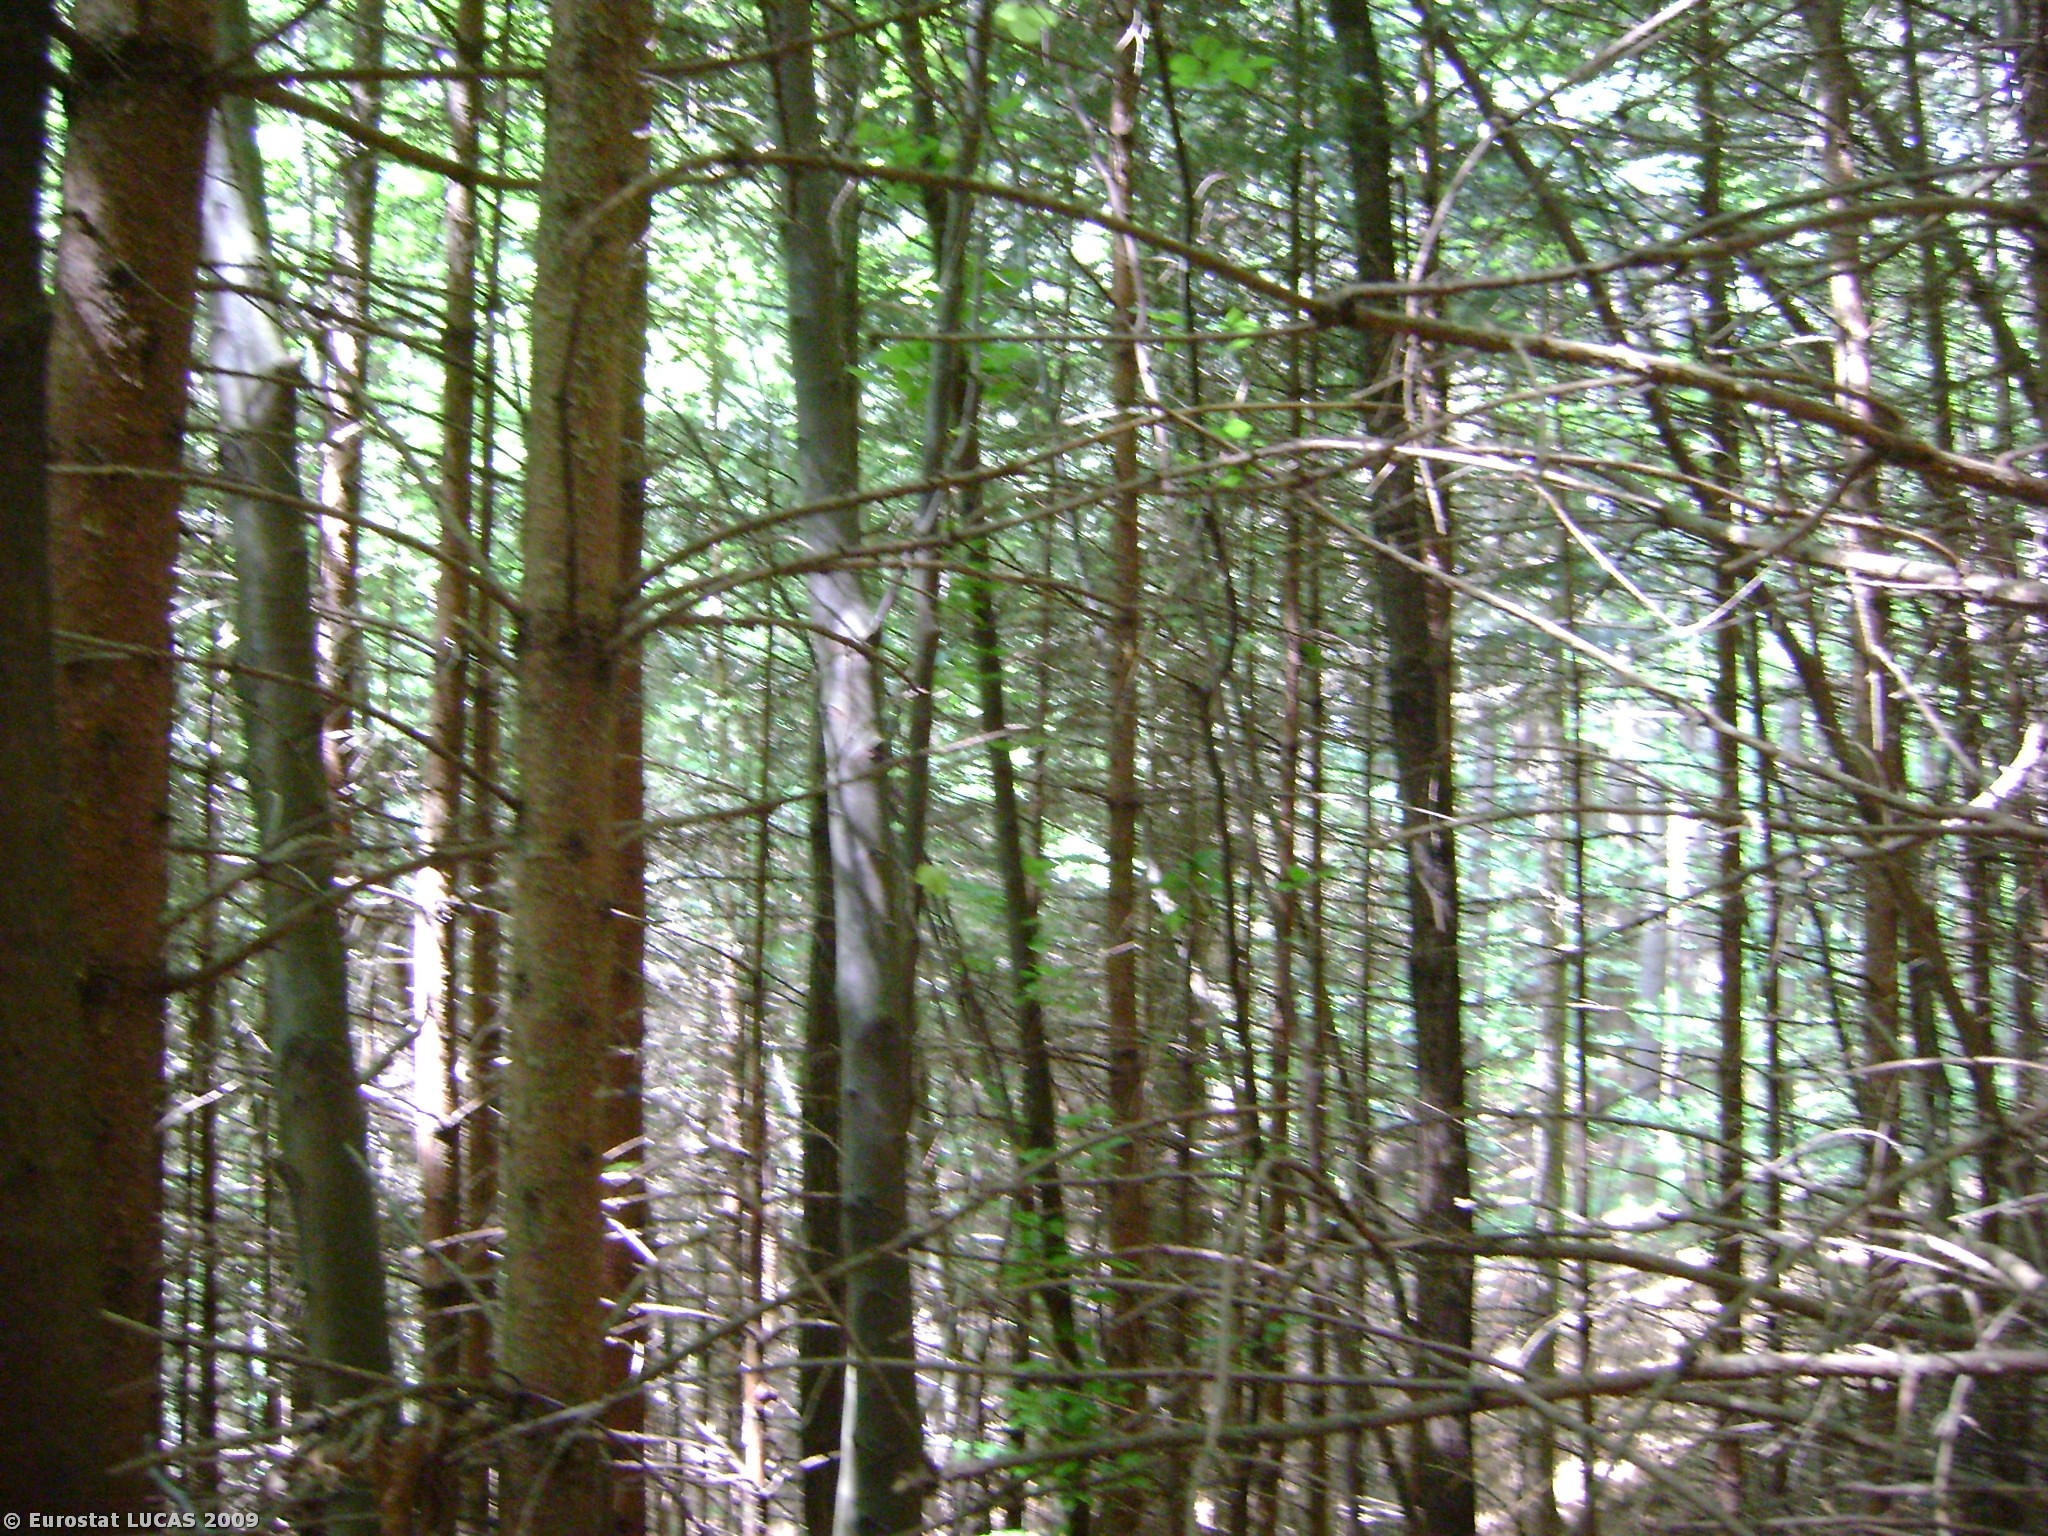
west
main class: Woodland
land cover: Coniferous woodland
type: boreal forest
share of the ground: > 75 %
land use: Forestry
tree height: > 5 m
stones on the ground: < 10 %
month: May
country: AT
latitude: 47.9235
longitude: 13.2509
